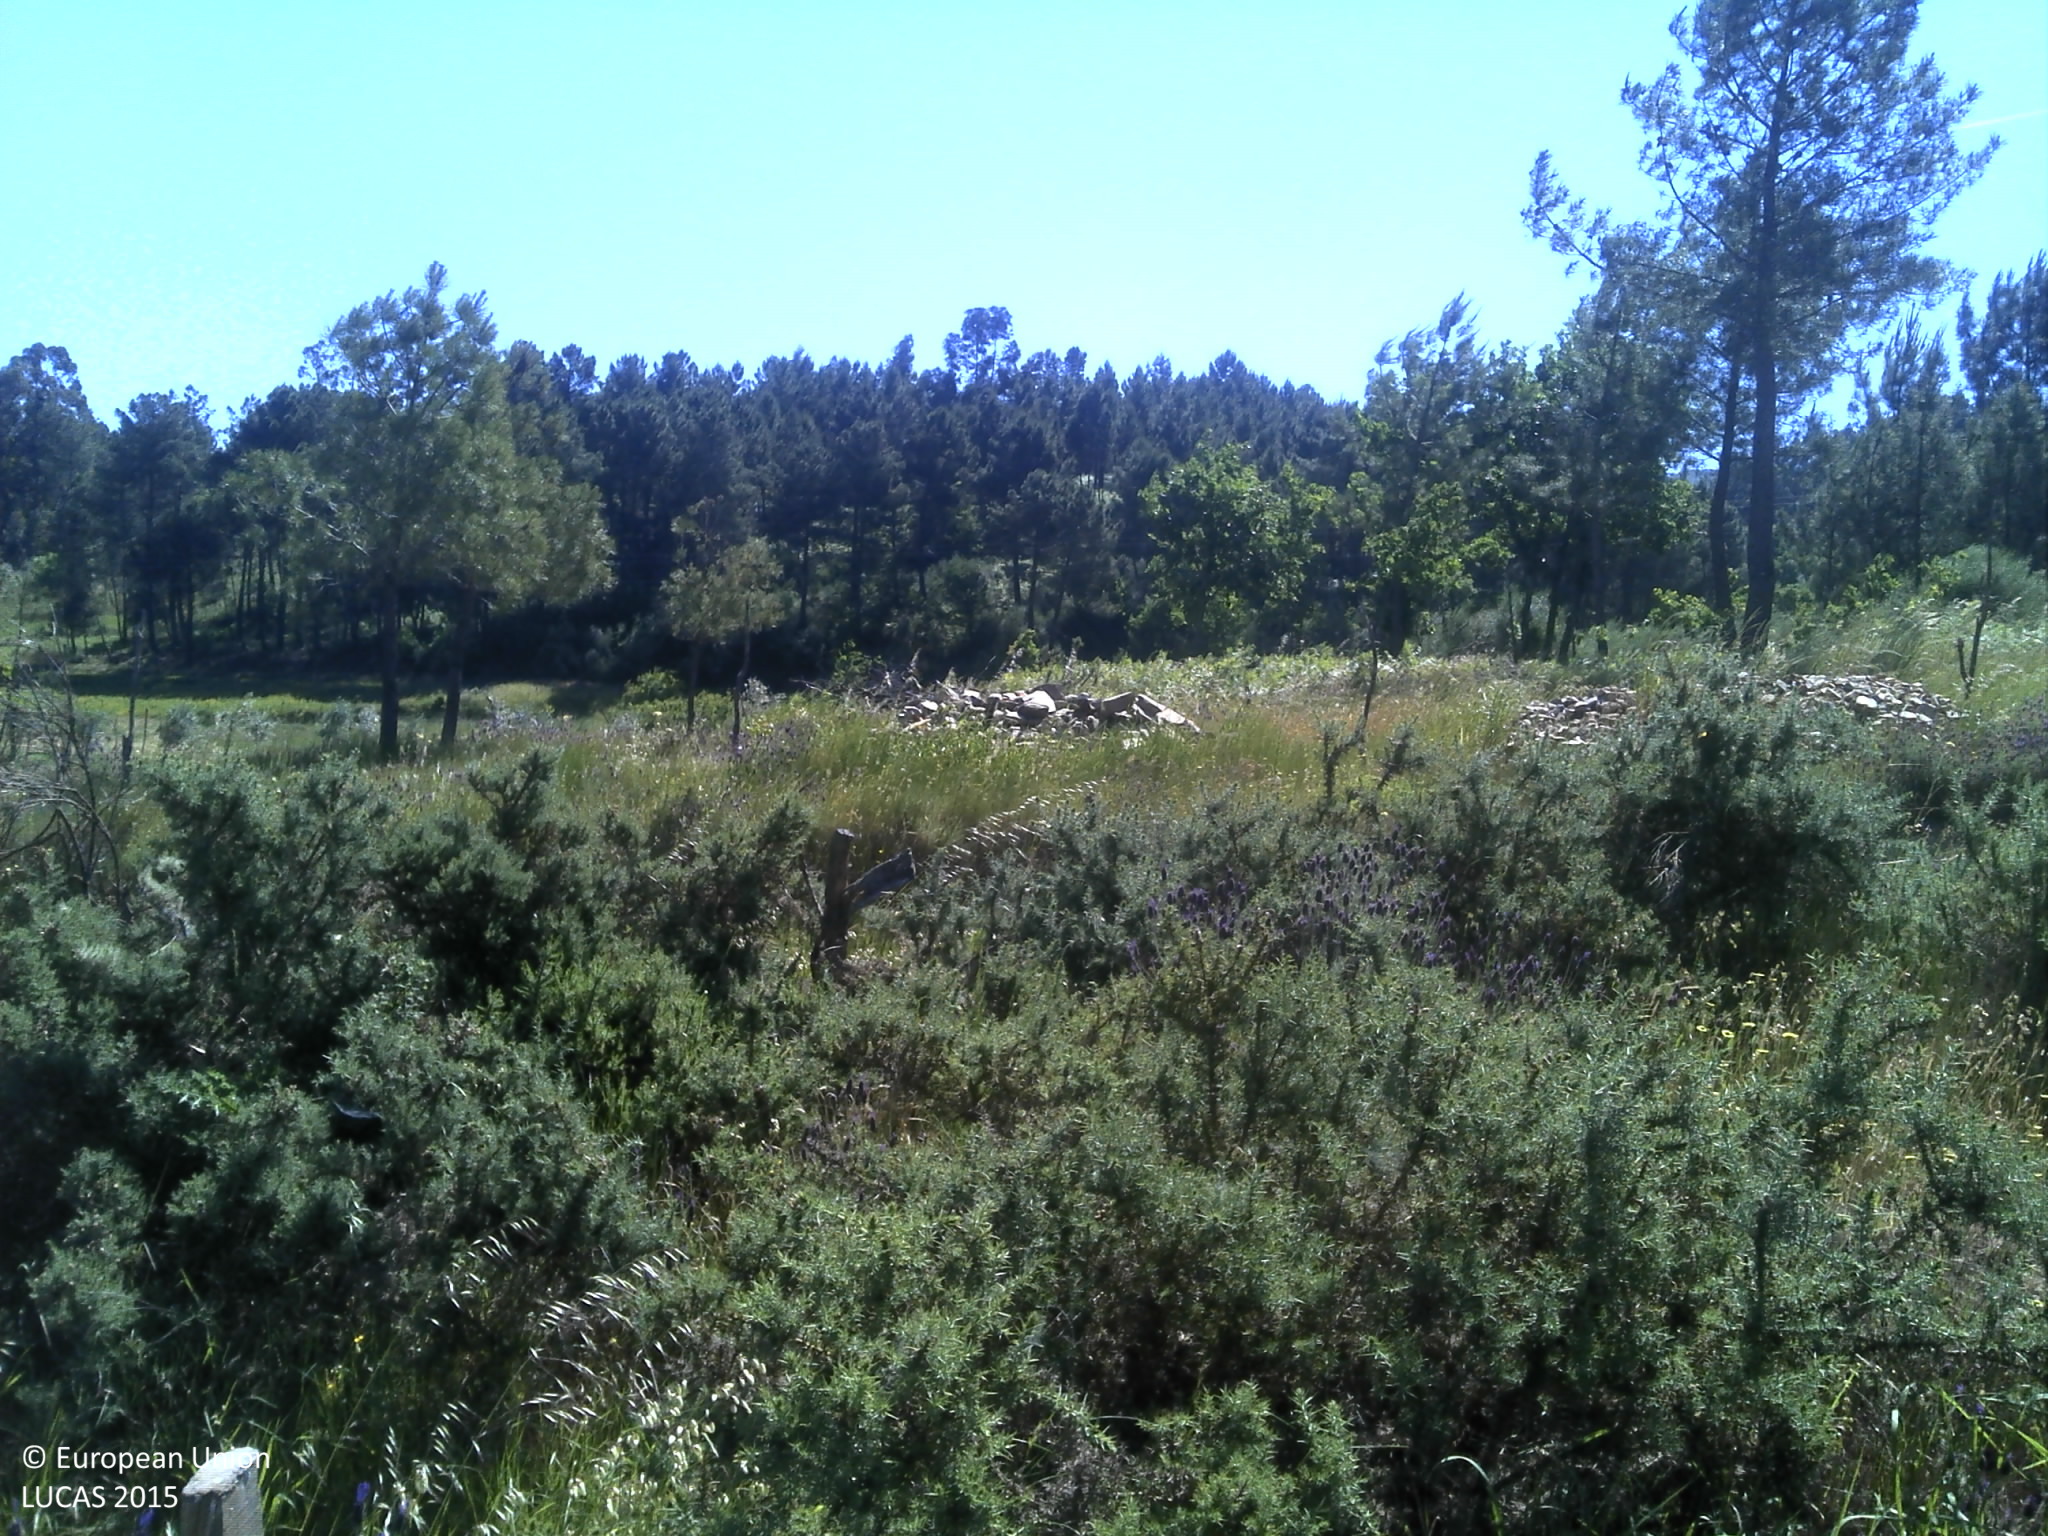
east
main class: Grassland
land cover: Grassland without tree/shrub cover
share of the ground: 25 - 50 %
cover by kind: unconsolidated bare surface 60 %, herbaceous plants 40 %
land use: Agriculture (excluding fallow land and kitchen gardens)
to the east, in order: Grassland without tree/shrub cover; Fences; Grass margins; Electric lines; Tracks; Shrubland with sparse tree cover; Vineyards; Grassland without tree/shrub cover; Grass margins; Grassland without tree/shrub cover; Shrubland with sparse tree cover; Pine dominated coniferous woodland; Shrubland with sparse tree cover
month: May
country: PT
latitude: 40.4102
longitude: -7.7326
